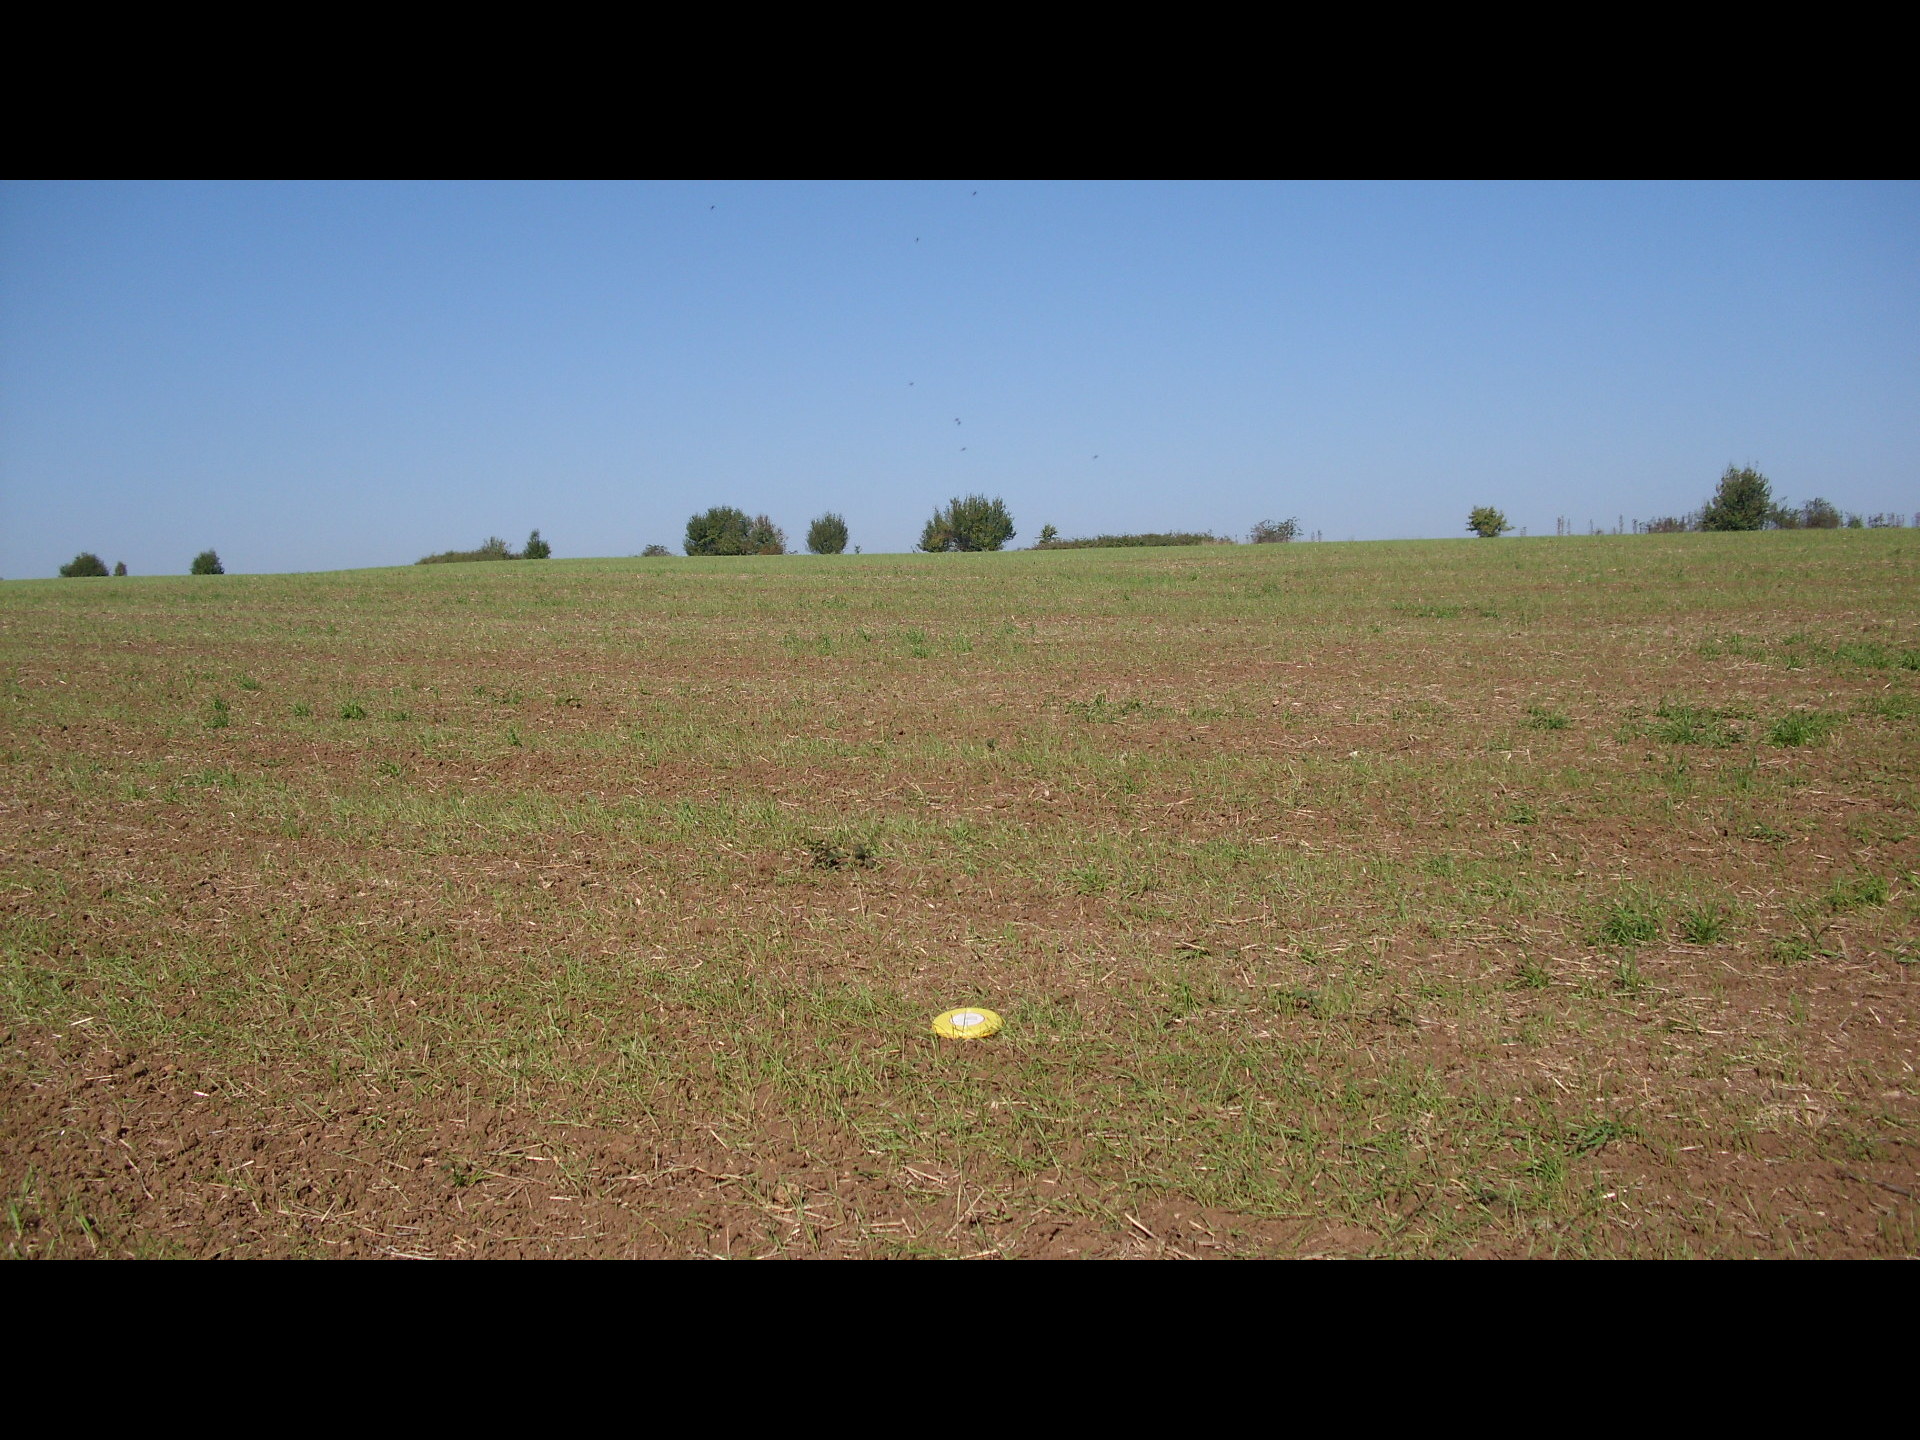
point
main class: Cropland
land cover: Common wheat
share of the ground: < 10 %
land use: Agriculture (excluding fallow land and kitchen gardens)
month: October
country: BG
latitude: 43.8538
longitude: 22.7381
